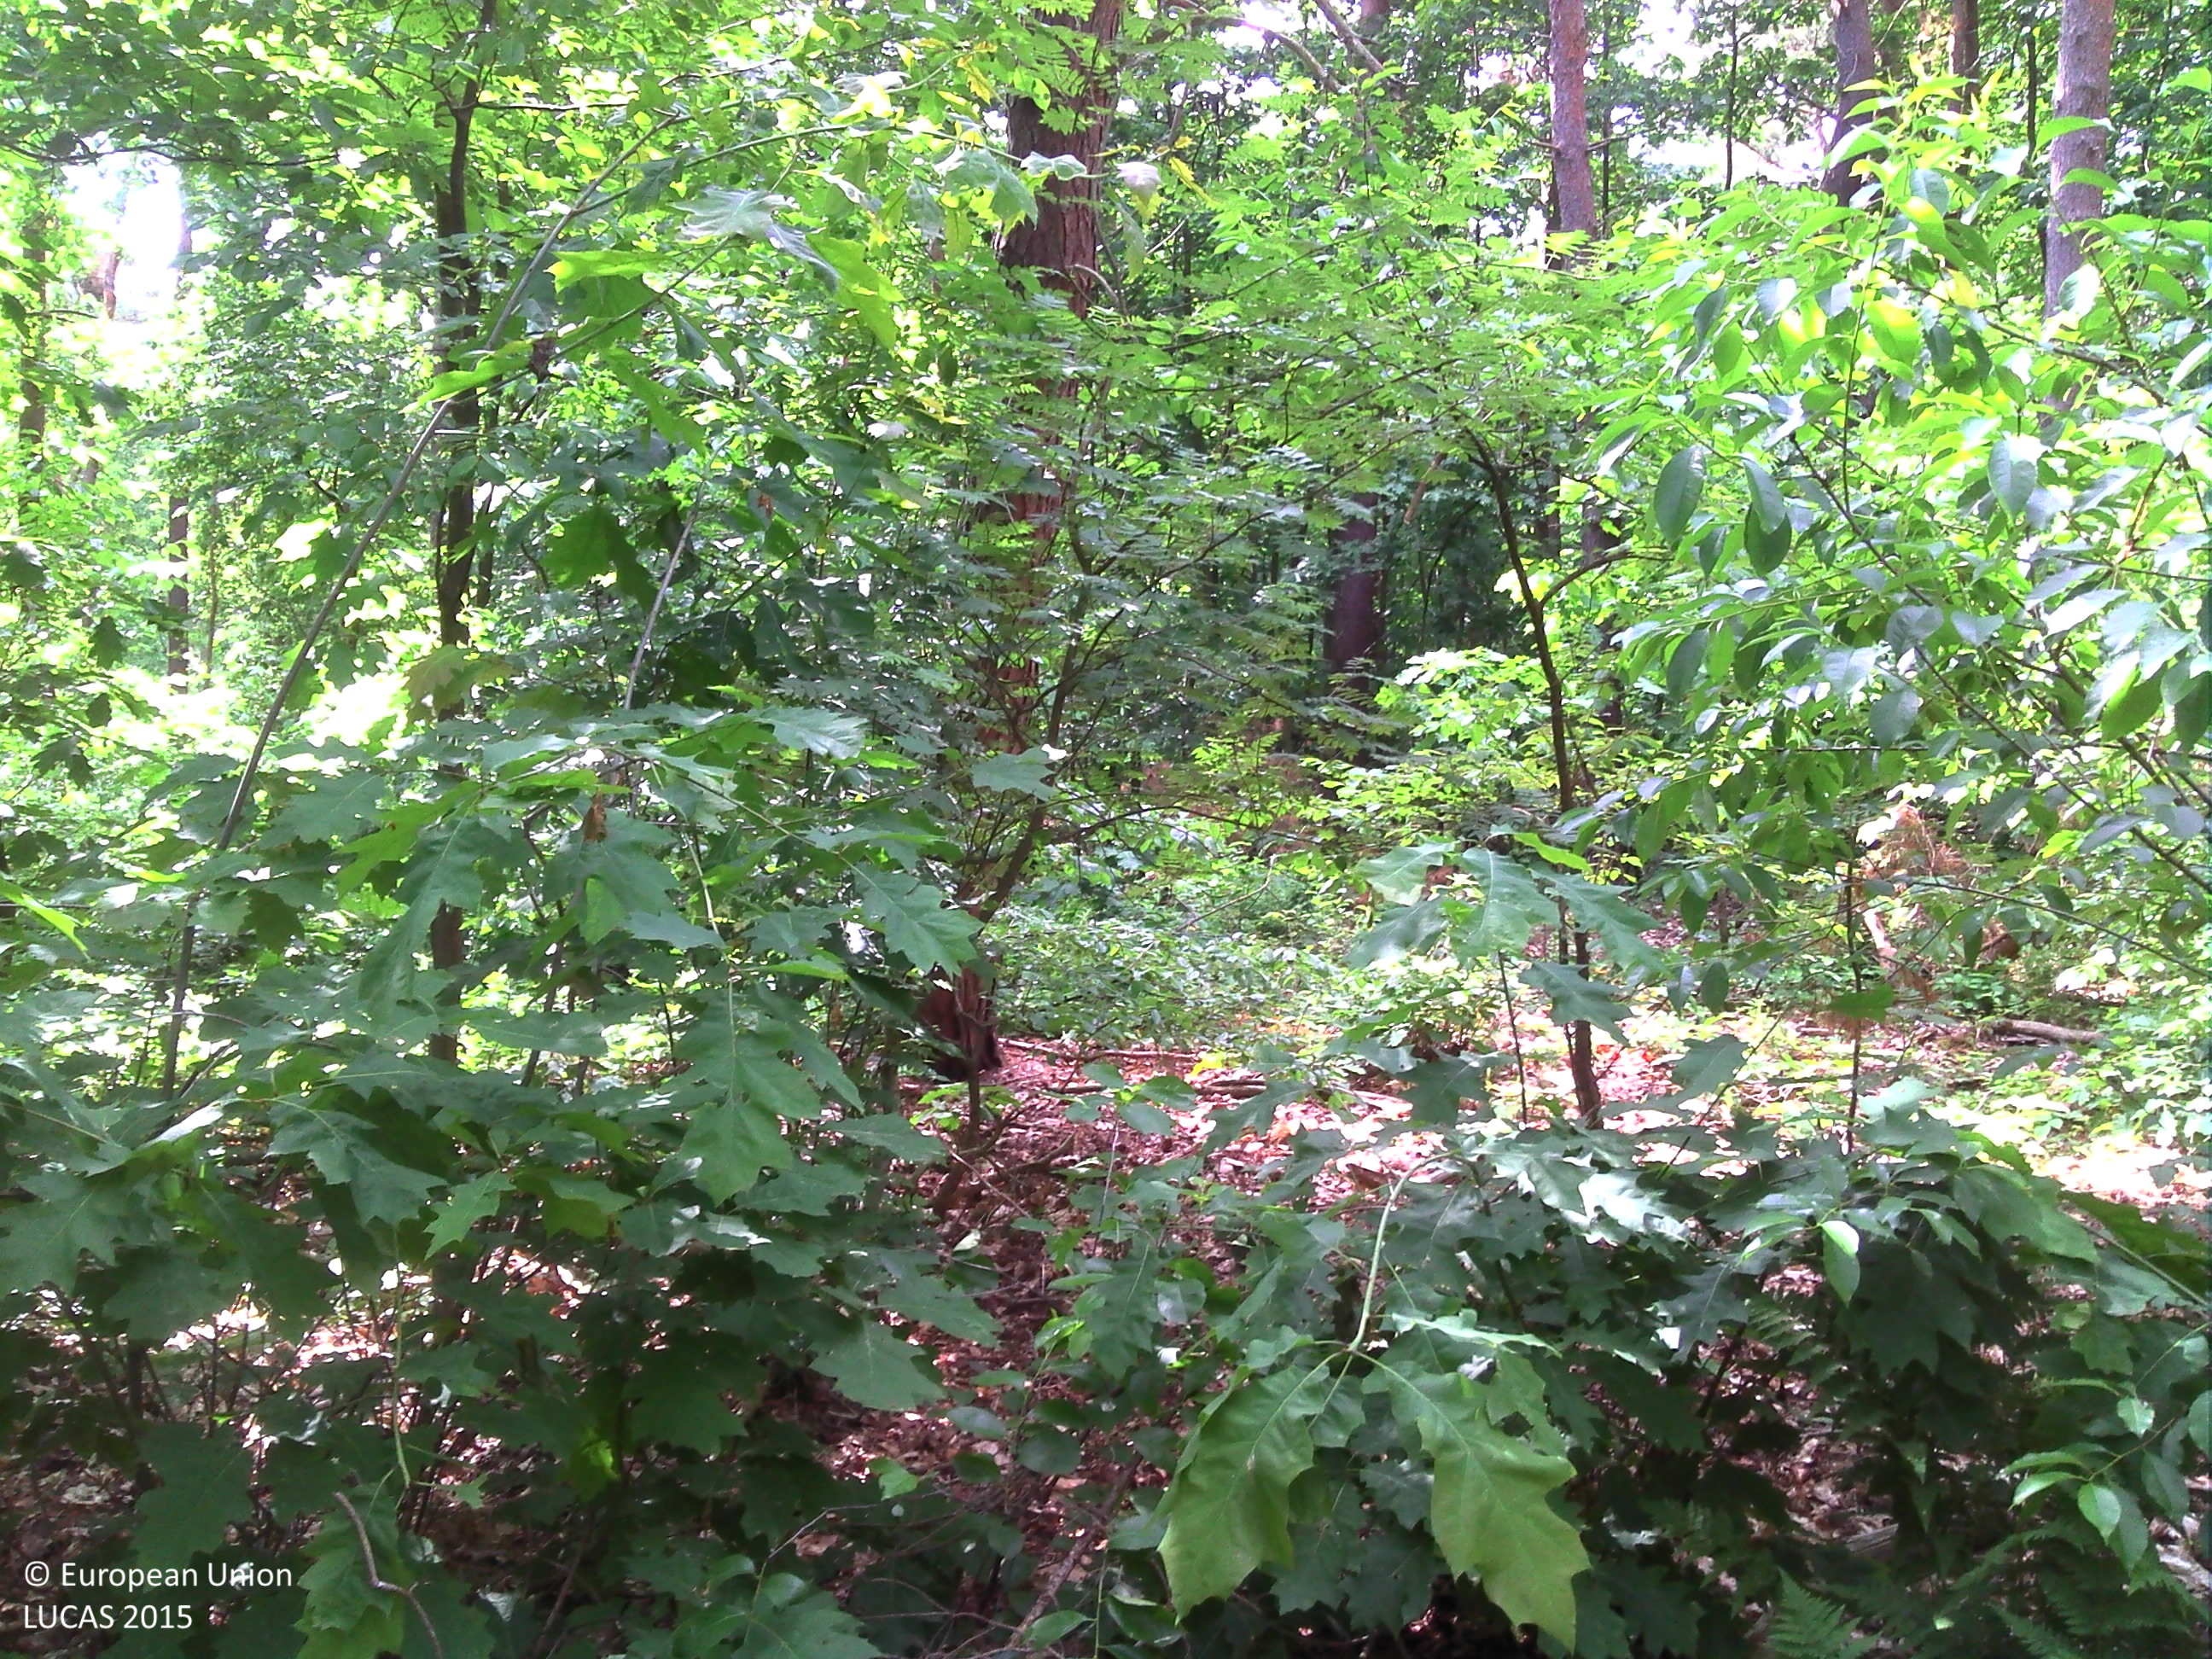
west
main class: Woodland
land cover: Pine dominated mixed woodland
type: exotic forest
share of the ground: > 75 %
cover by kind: broadleaved forest trees 70 %, coniferous forest trees 25 %, herbaceous plants 5 %
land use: Forestry
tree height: > 5 m
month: June
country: BE
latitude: 51.0756
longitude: 5.7023
